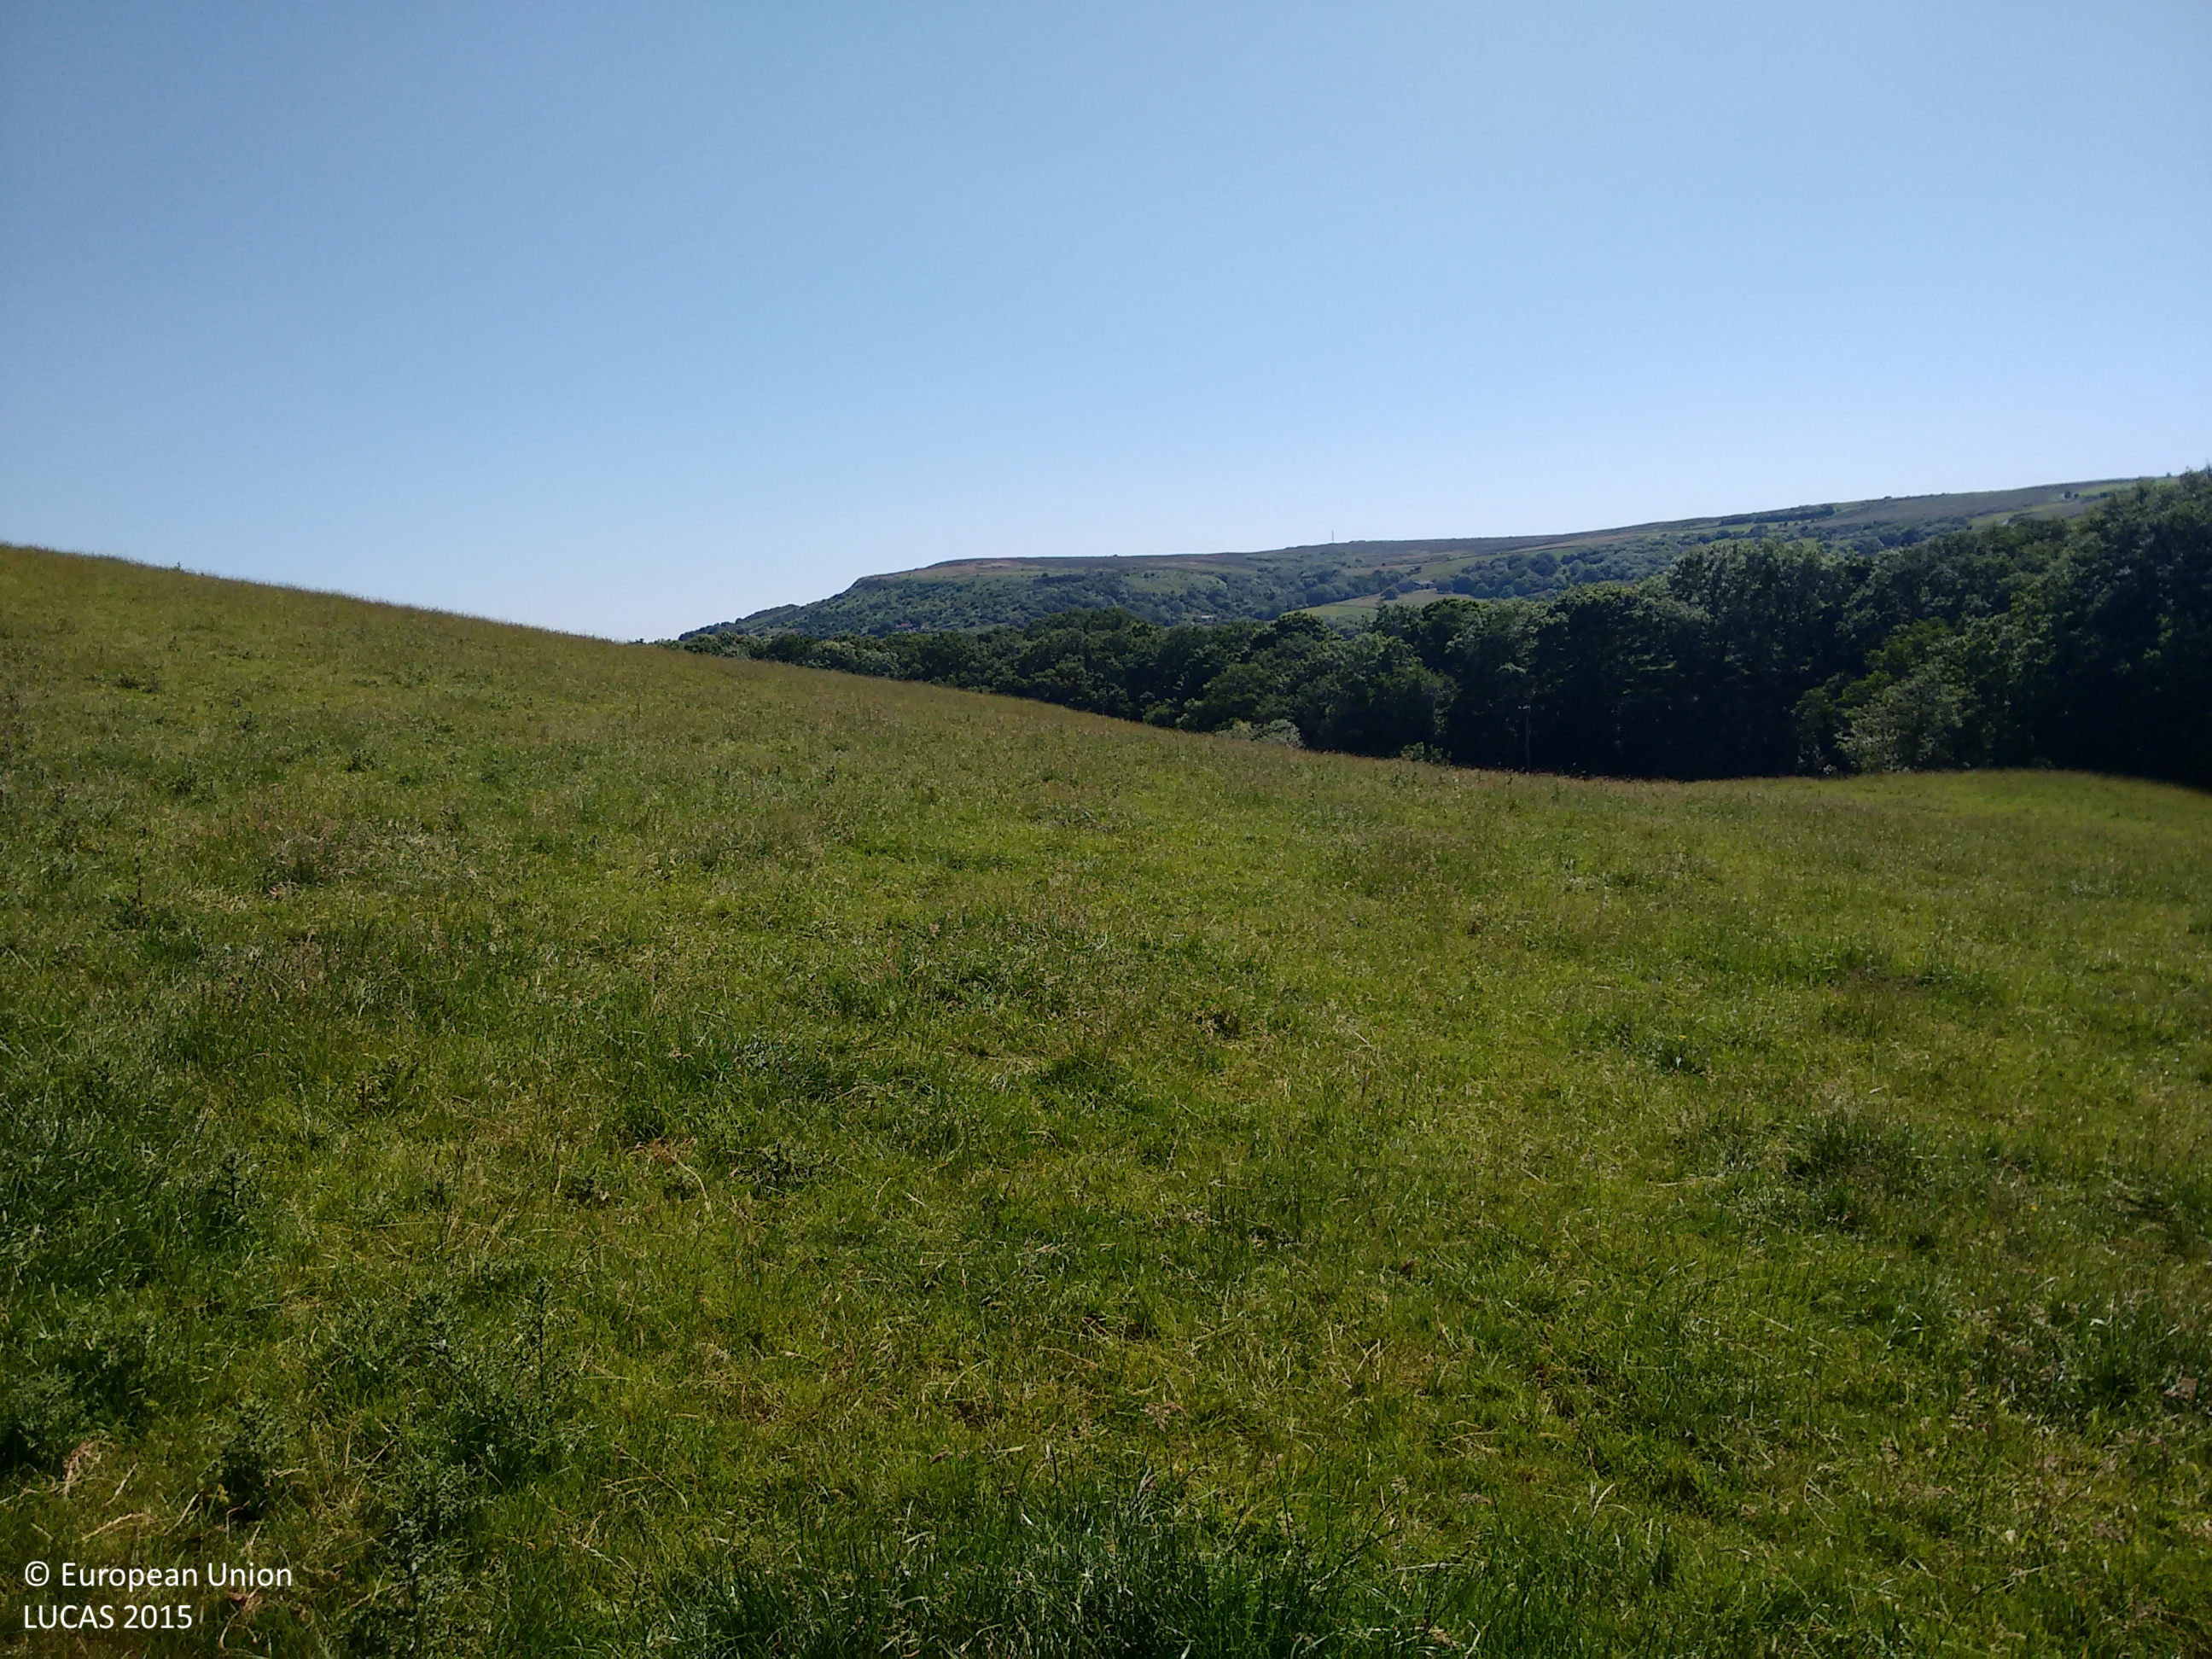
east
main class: Grassland
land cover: Grassland without tree/shrub cover
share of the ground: > 75 %
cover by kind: herbaceous plants 100 %
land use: Agriculture (excluding fallow land and kitchen gardens)
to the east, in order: Grassland without tree/shrub cover; Electric lines; Grassland without tree/shrub cover
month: July
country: GB
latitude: 54.4082
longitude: -0.5594
